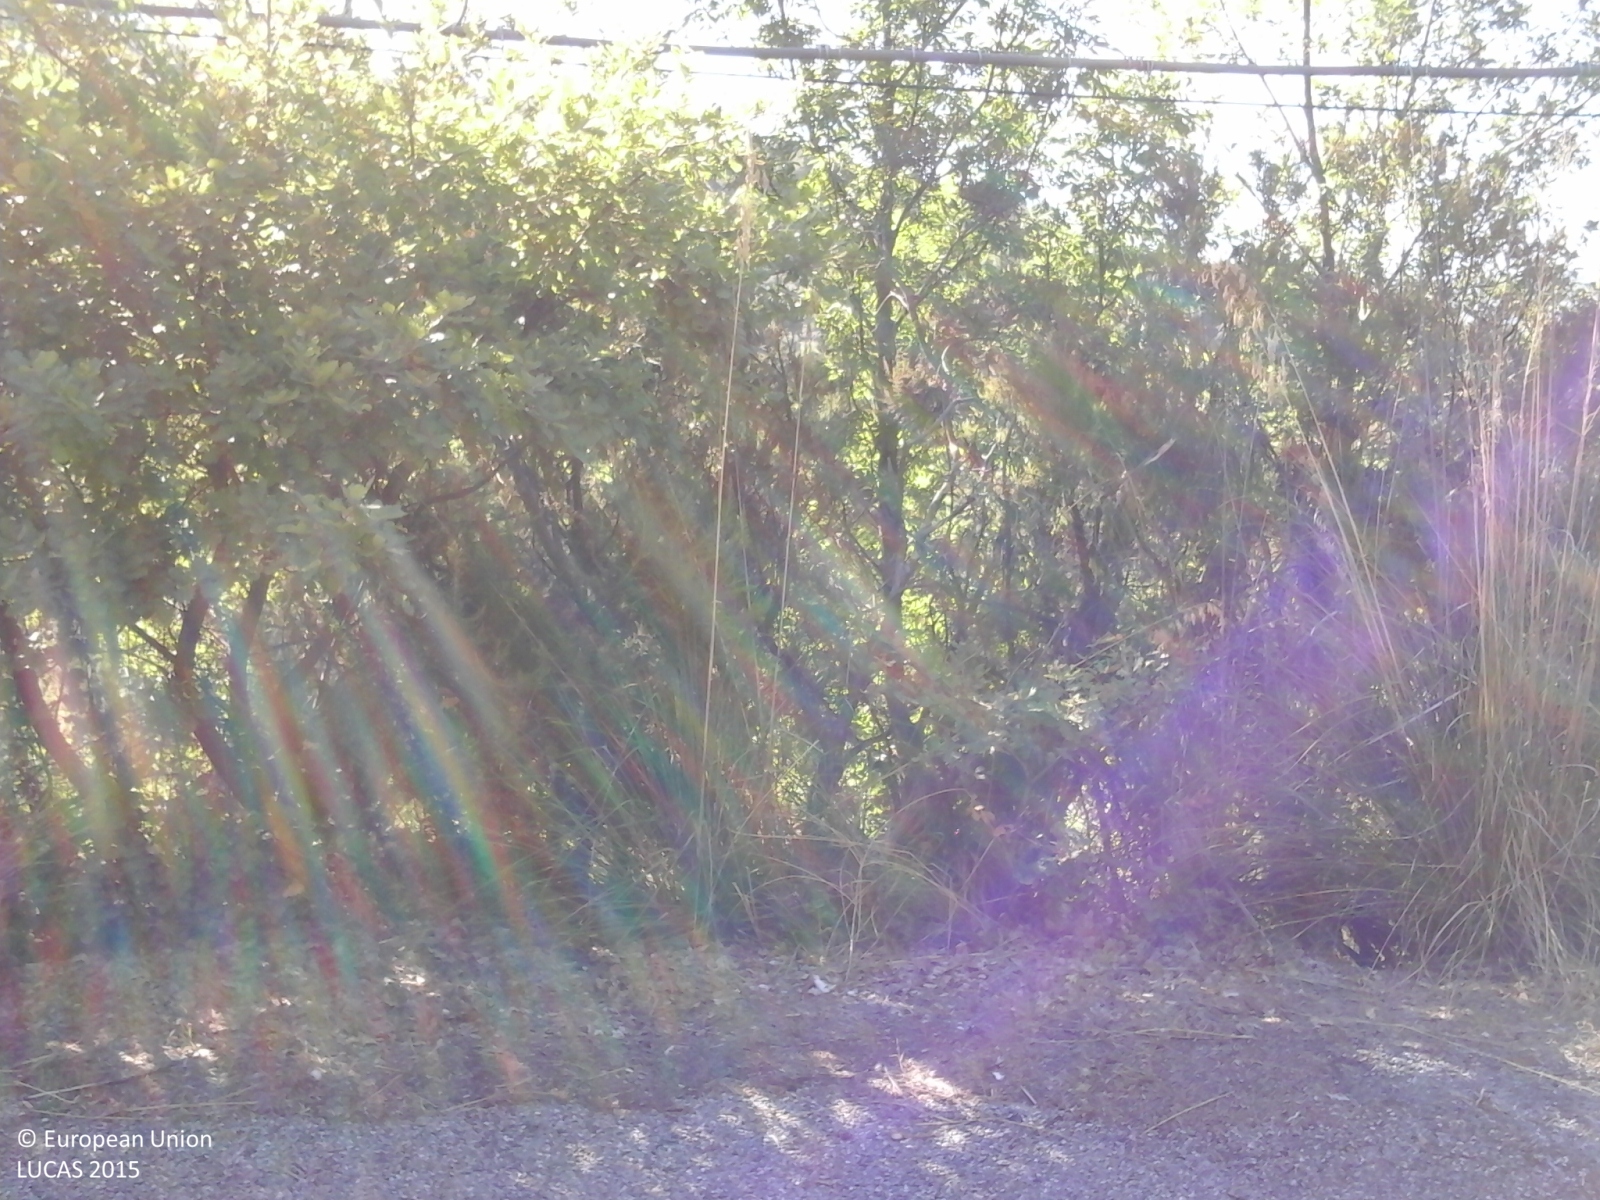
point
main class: Shrubland
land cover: Shrubland with sparse tree cover
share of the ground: > 75 %
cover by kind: shrubs 75 %, herbaceous plants 20 %, broadleaved forest trees 5 %
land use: Abandoned areas
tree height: > 5 m
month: August
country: IT
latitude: 40.2620
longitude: 15.0923
